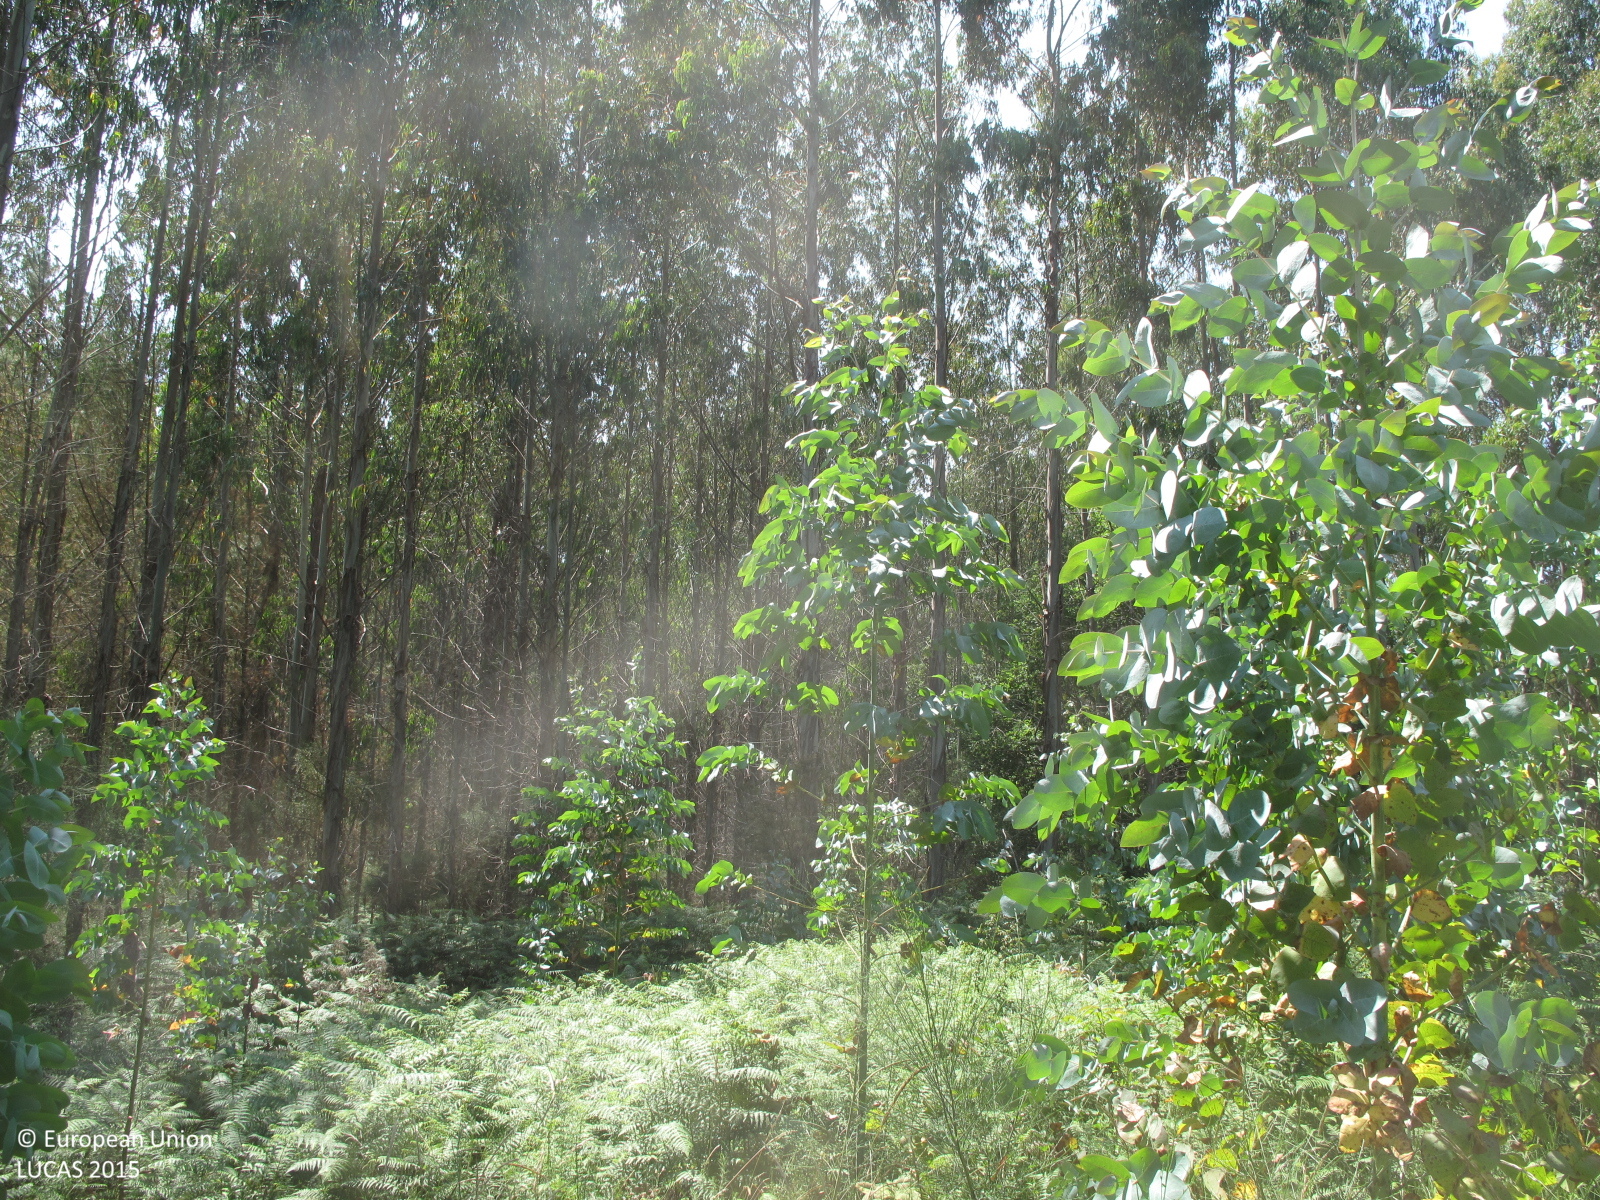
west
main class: Woodland
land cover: Broadleaved woodland
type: exotic forest
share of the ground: 10 - 25 %
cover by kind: shrubs 40 %, herbaceous plants 40 %, broadleaved forest trees 20 %
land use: Forestry
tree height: < 5 m
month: June
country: ES
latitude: 43.0289
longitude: -8.0462
